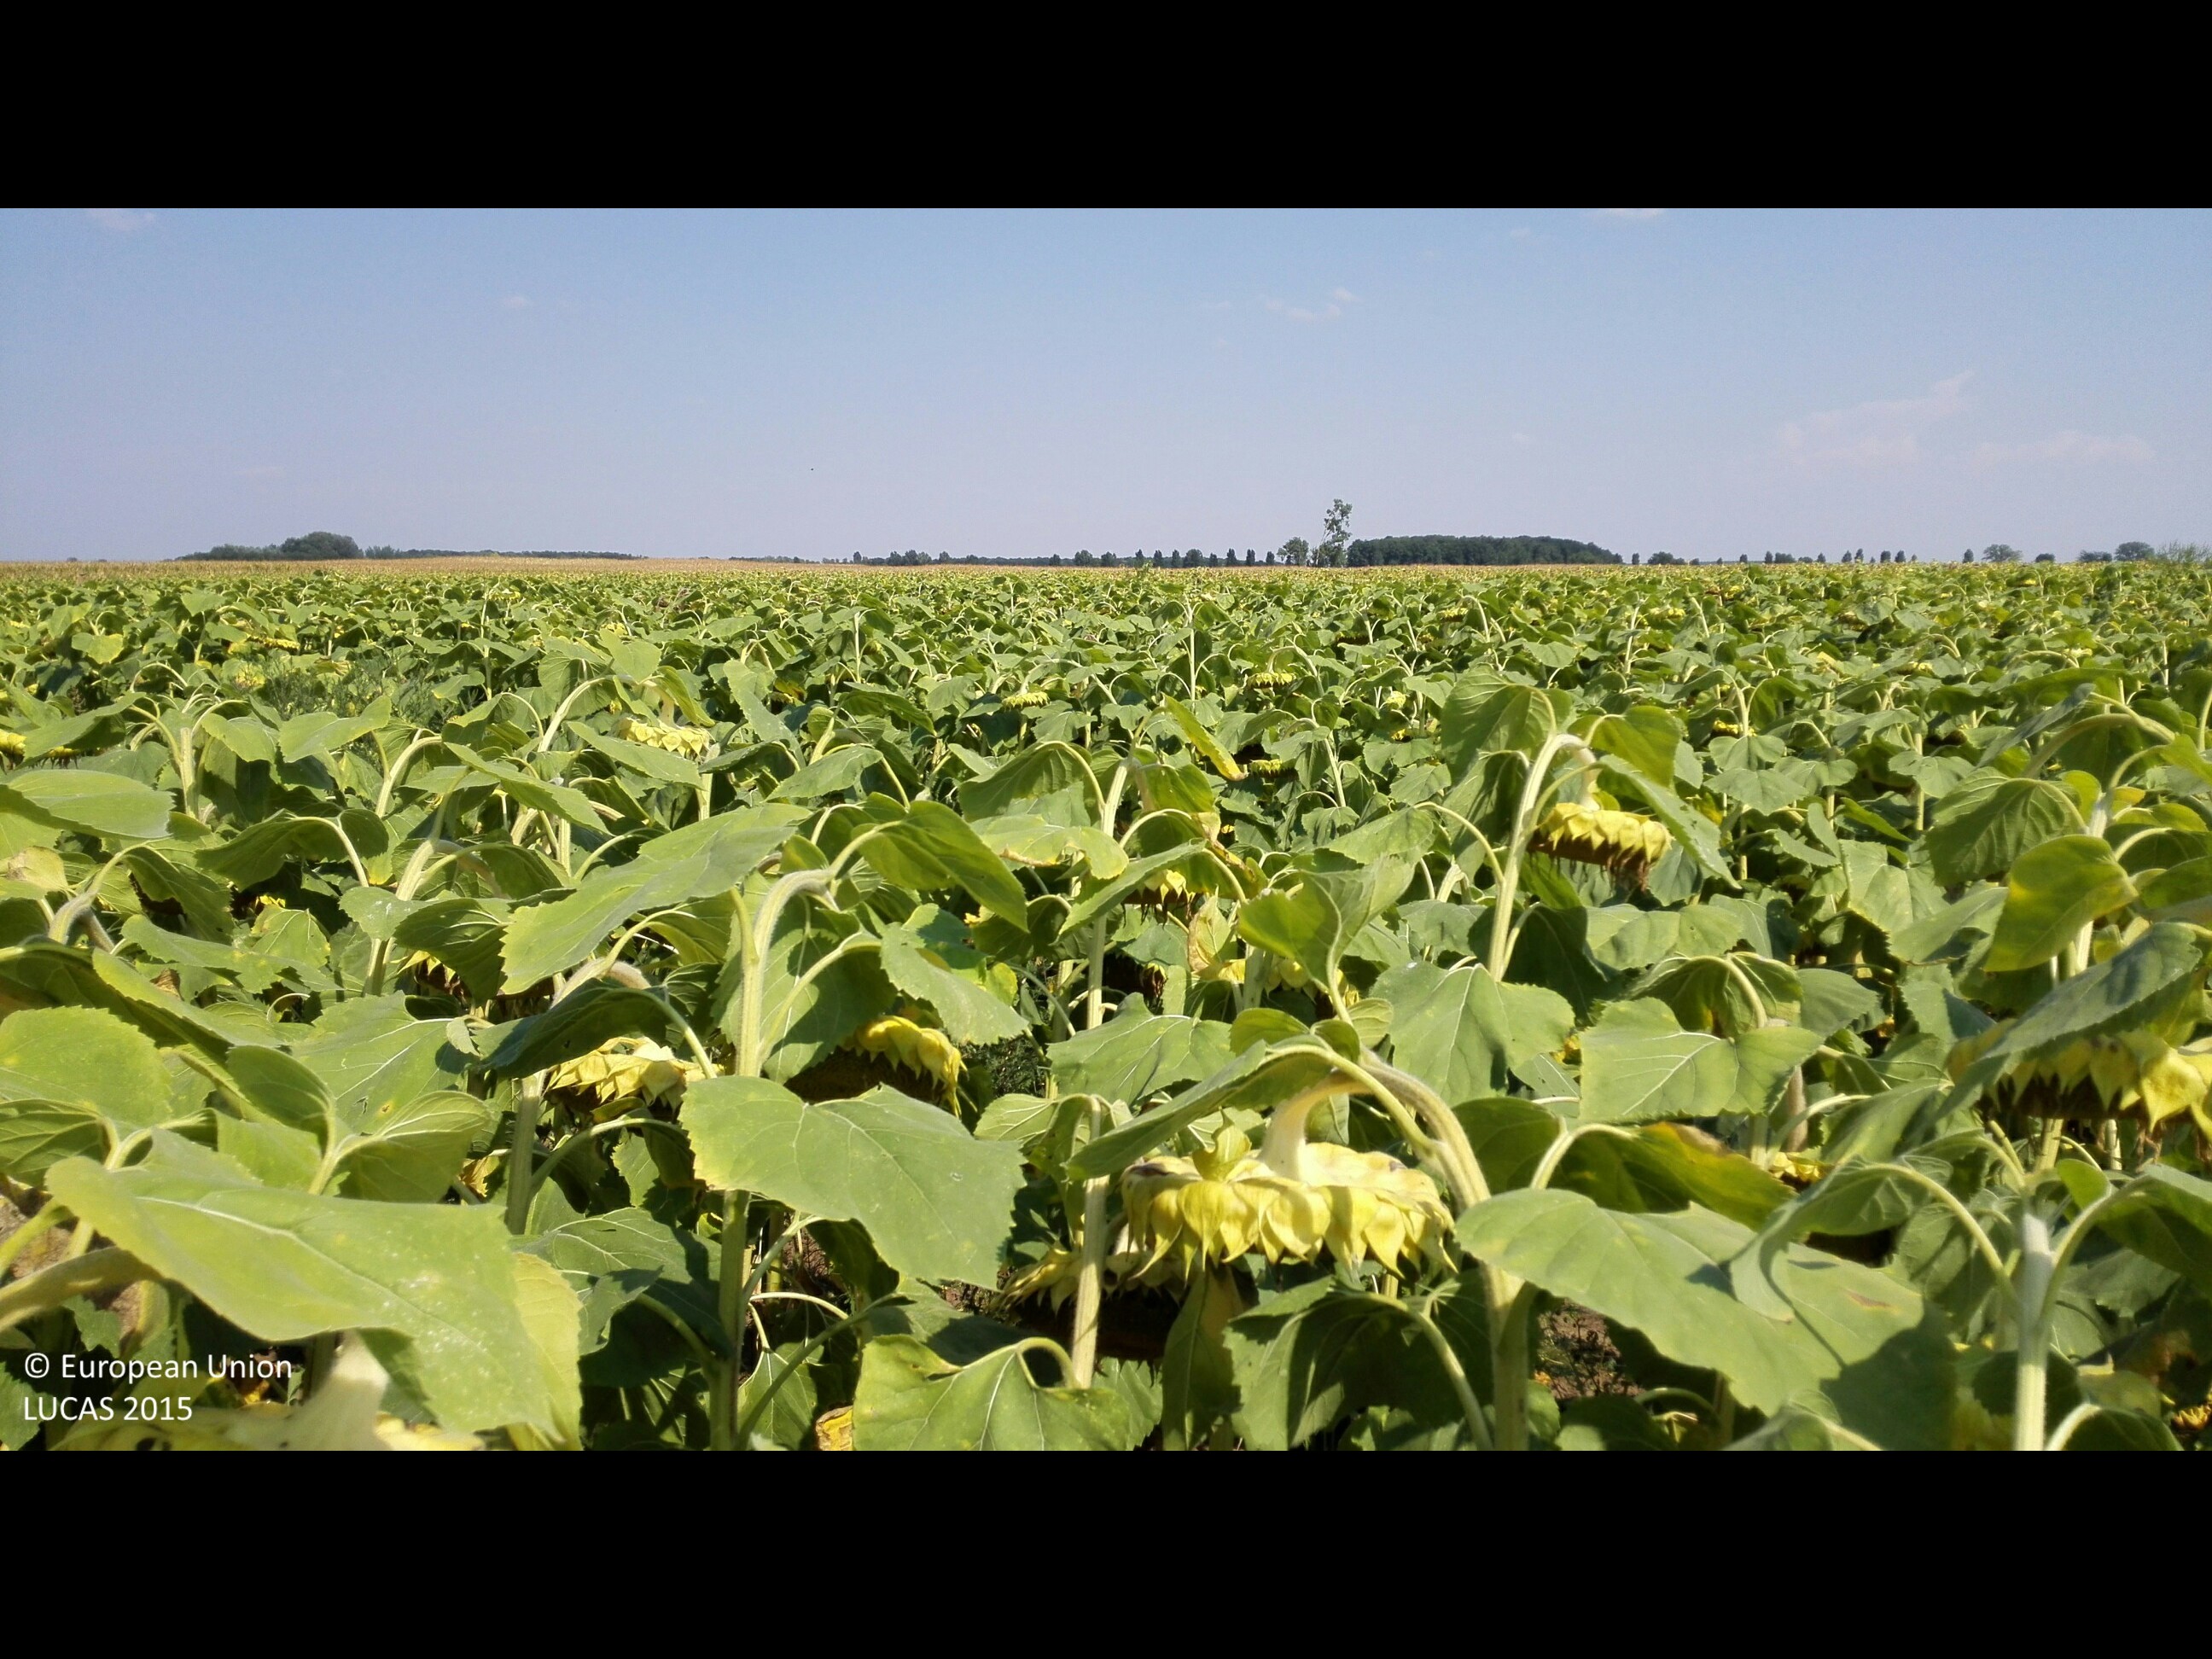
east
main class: Cropland
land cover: Sunflower
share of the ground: > 75 %
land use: Agriculture (excluding fallow land and kitchen gardens)
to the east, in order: Sunflower; Grass margins; Tracks; Grass margins; Maize
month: August
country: HU
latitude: 47.3748
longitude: 21.5786
